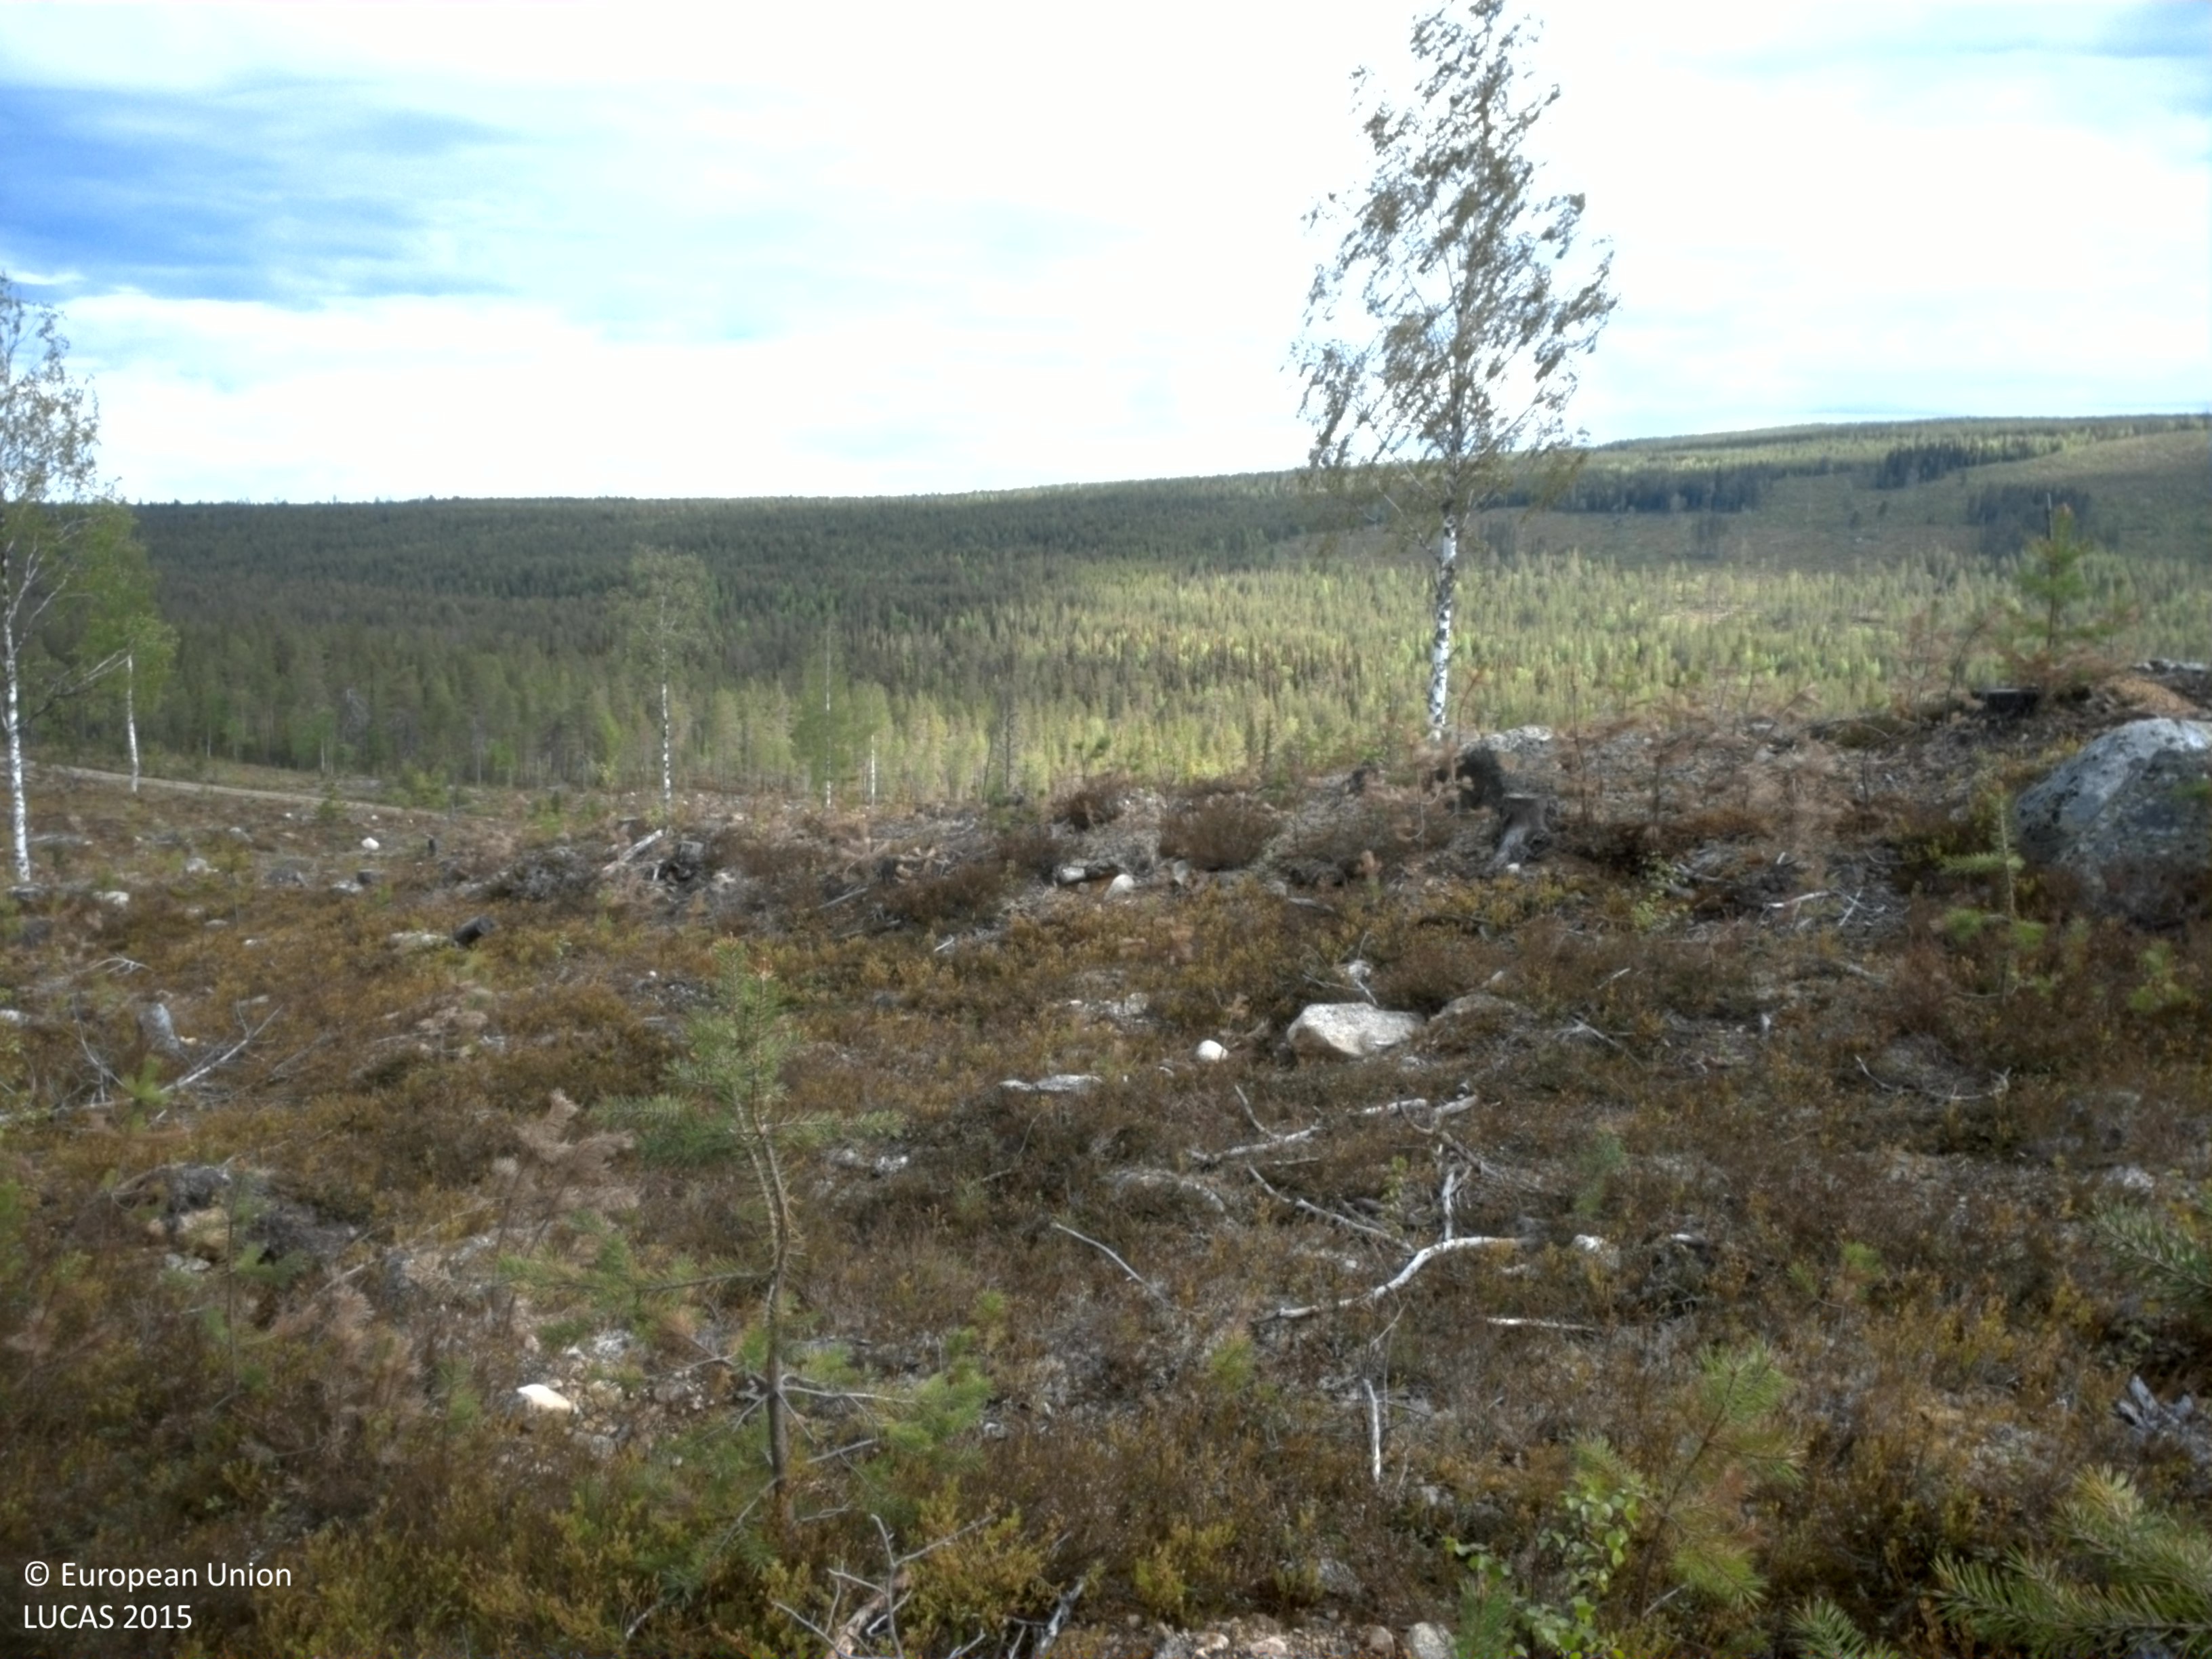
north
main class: Shrubland
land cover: Shrubland with sparse tree cover
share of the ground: > 75 %
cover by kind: shrubs 85 %, coniferous forest trees 5 %, lichens and mosses 5 %, consolidated bare surface 5 %
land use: Forestry
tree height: < 5 m
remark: Clear cut
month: June
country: SE
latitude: 65.9399
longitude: 19.7408
